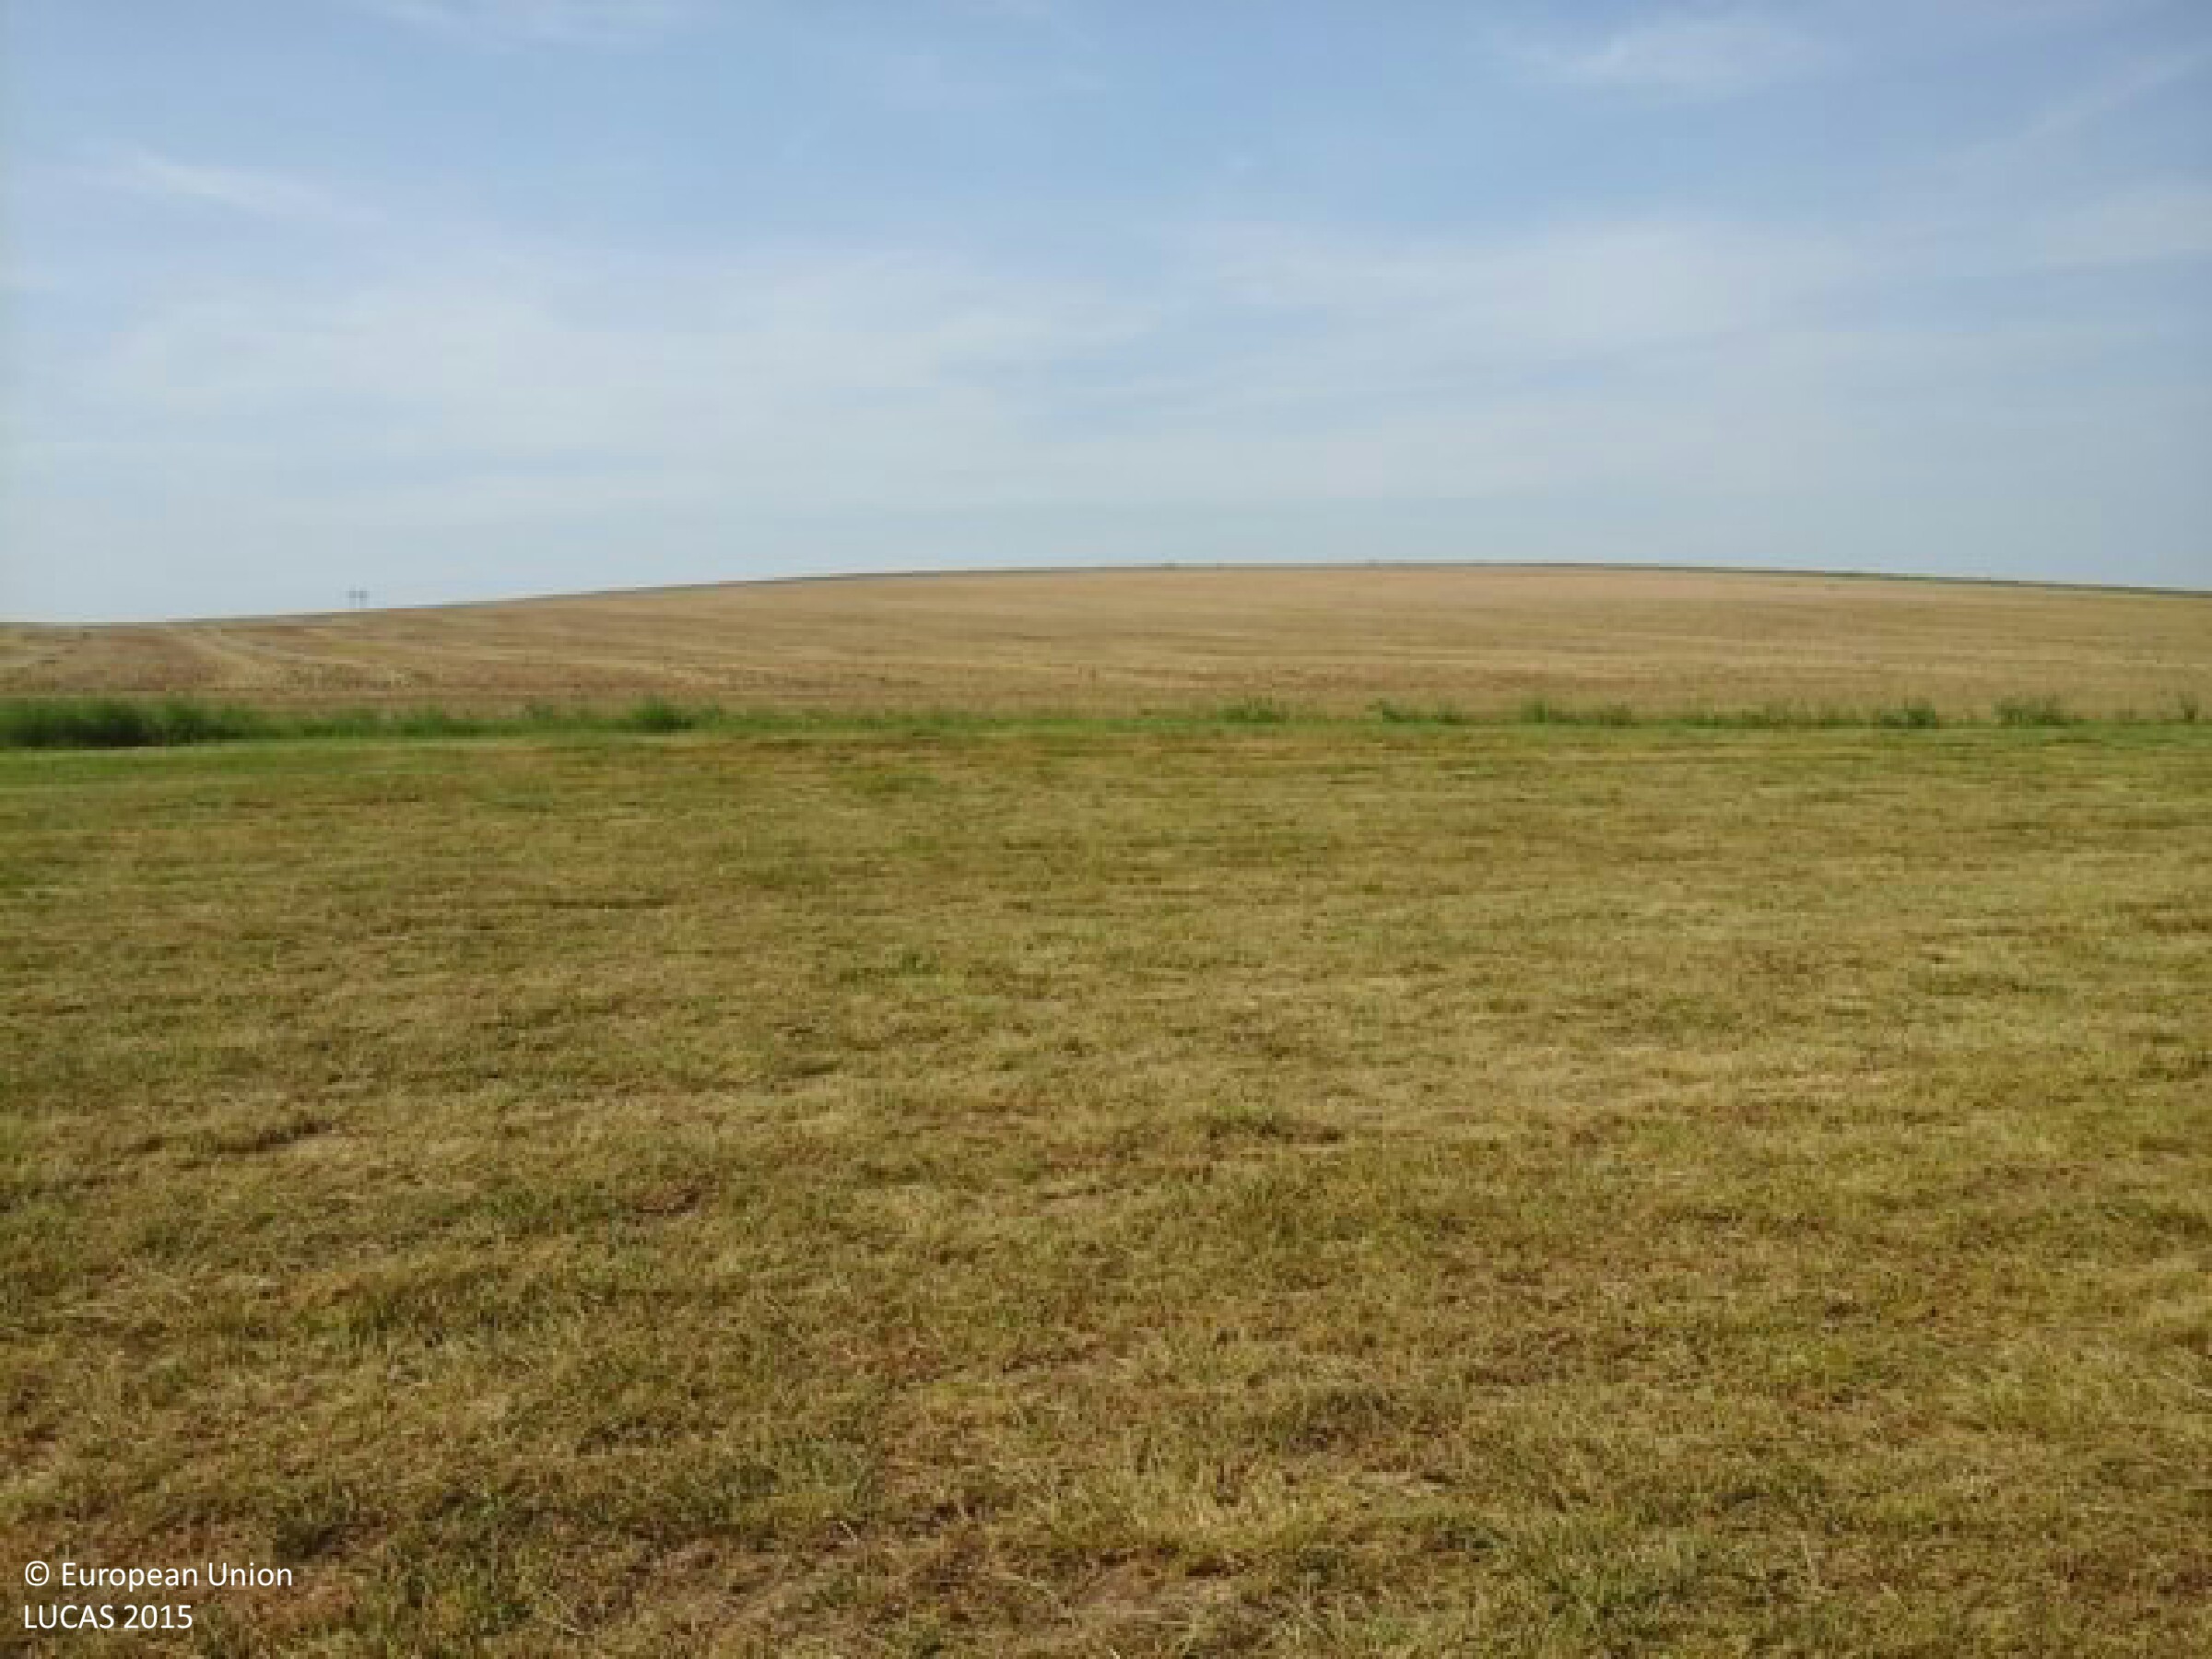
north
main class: Woodland
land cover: Broadleaved woodland
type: mesophytic deciduous forest
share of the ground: > 75 %
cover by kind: broadleaved forest trees 95 %, herbaceous plants 5 %
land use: Forestry
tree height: < 5 m
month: August
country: HU
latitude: 46.4843
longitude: 18.2545
